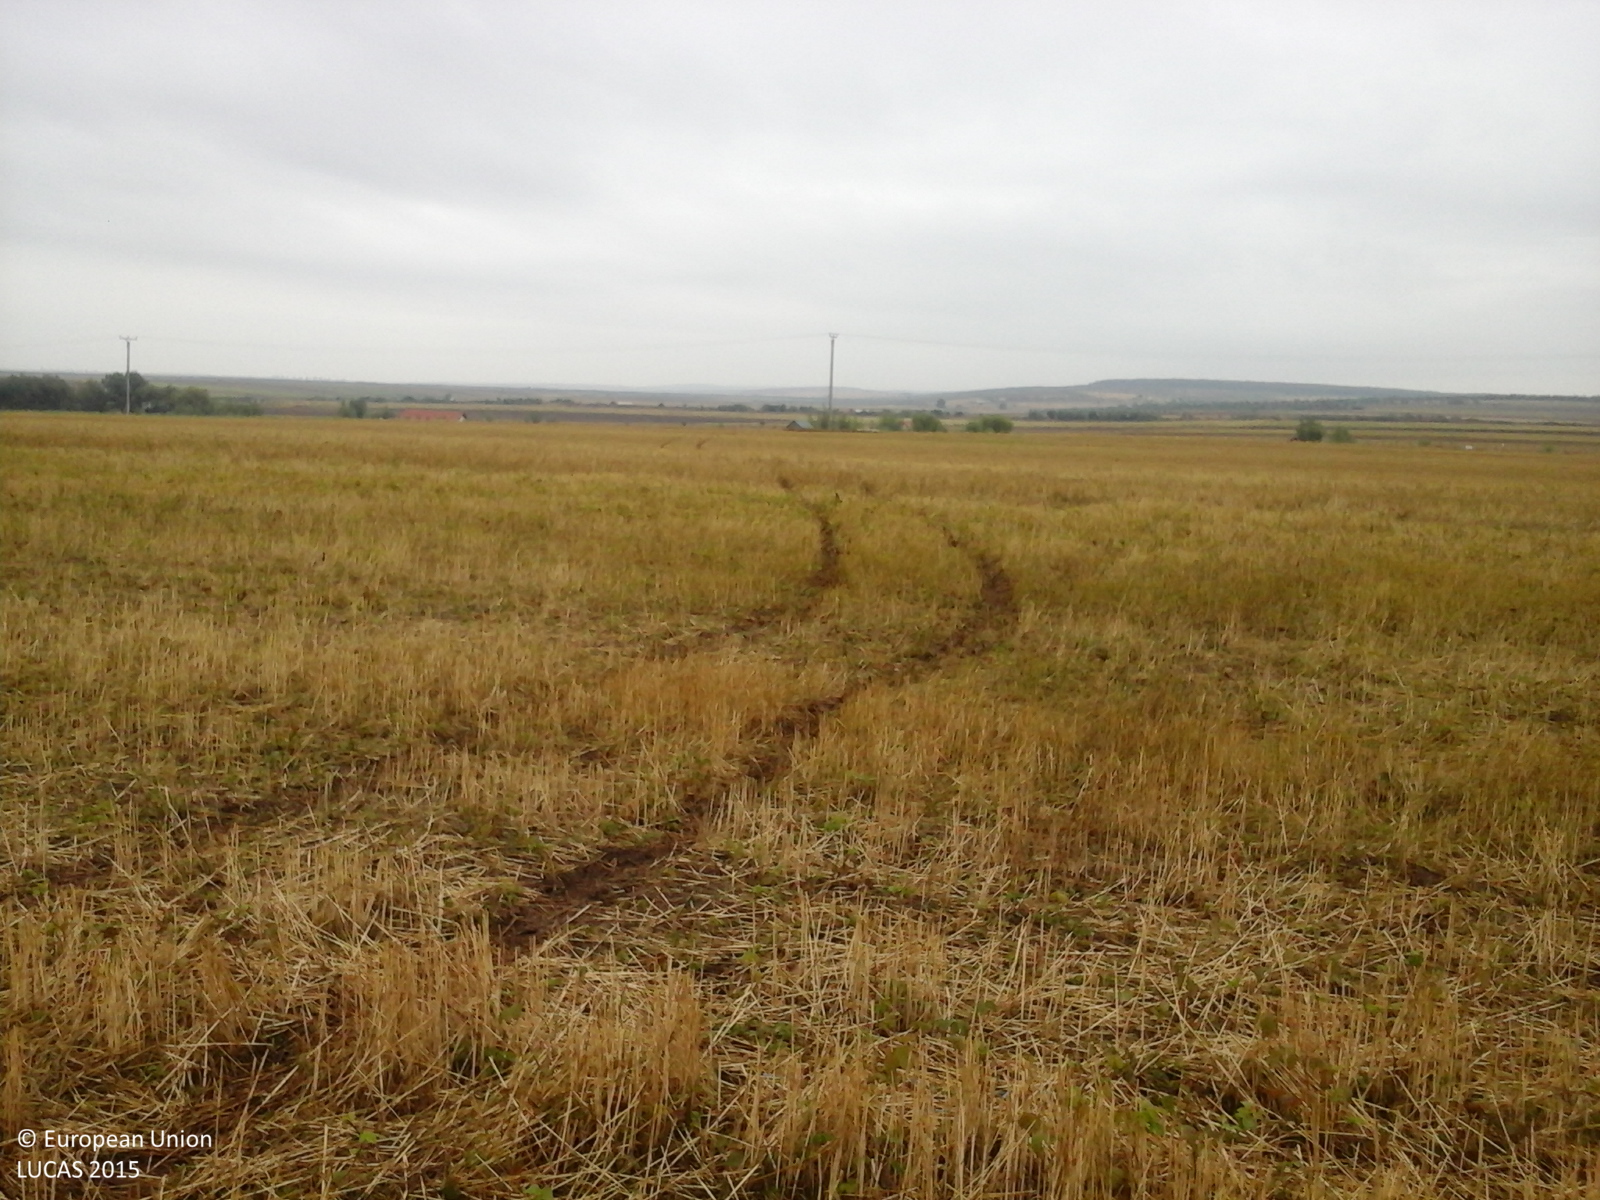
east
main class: Cropland
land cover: Common wheat
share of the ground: > 75 %
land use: Agriculture (excluding fallow land and kitchen gardens)
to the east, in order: Common wheat; Electric lines; Common wheat
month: August
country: RO
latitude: 46.0232
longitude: 21.4671
